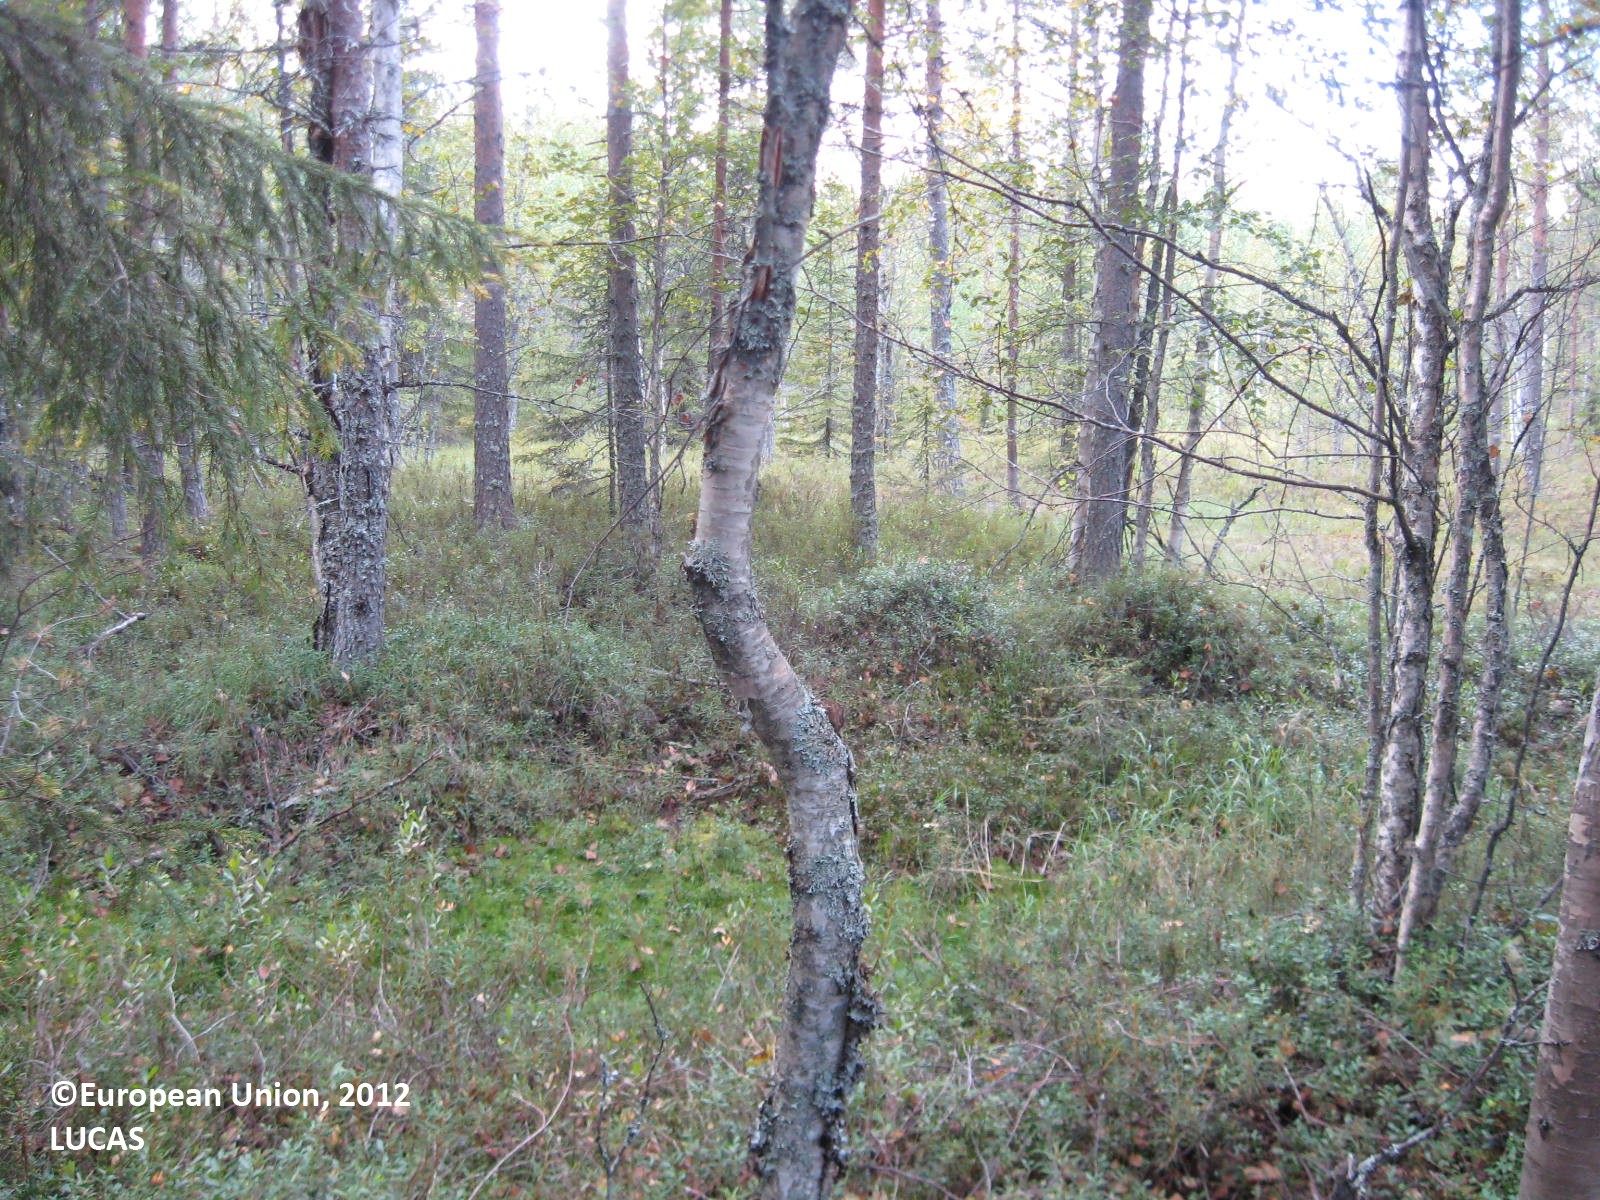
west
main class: Woodland
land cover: Pine dominated mixed woodland
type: boreal forest
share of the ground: > 75 %
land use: Forestry
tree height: > 5 m
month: August
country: FI
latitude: 63.6434
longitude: 29.2958
